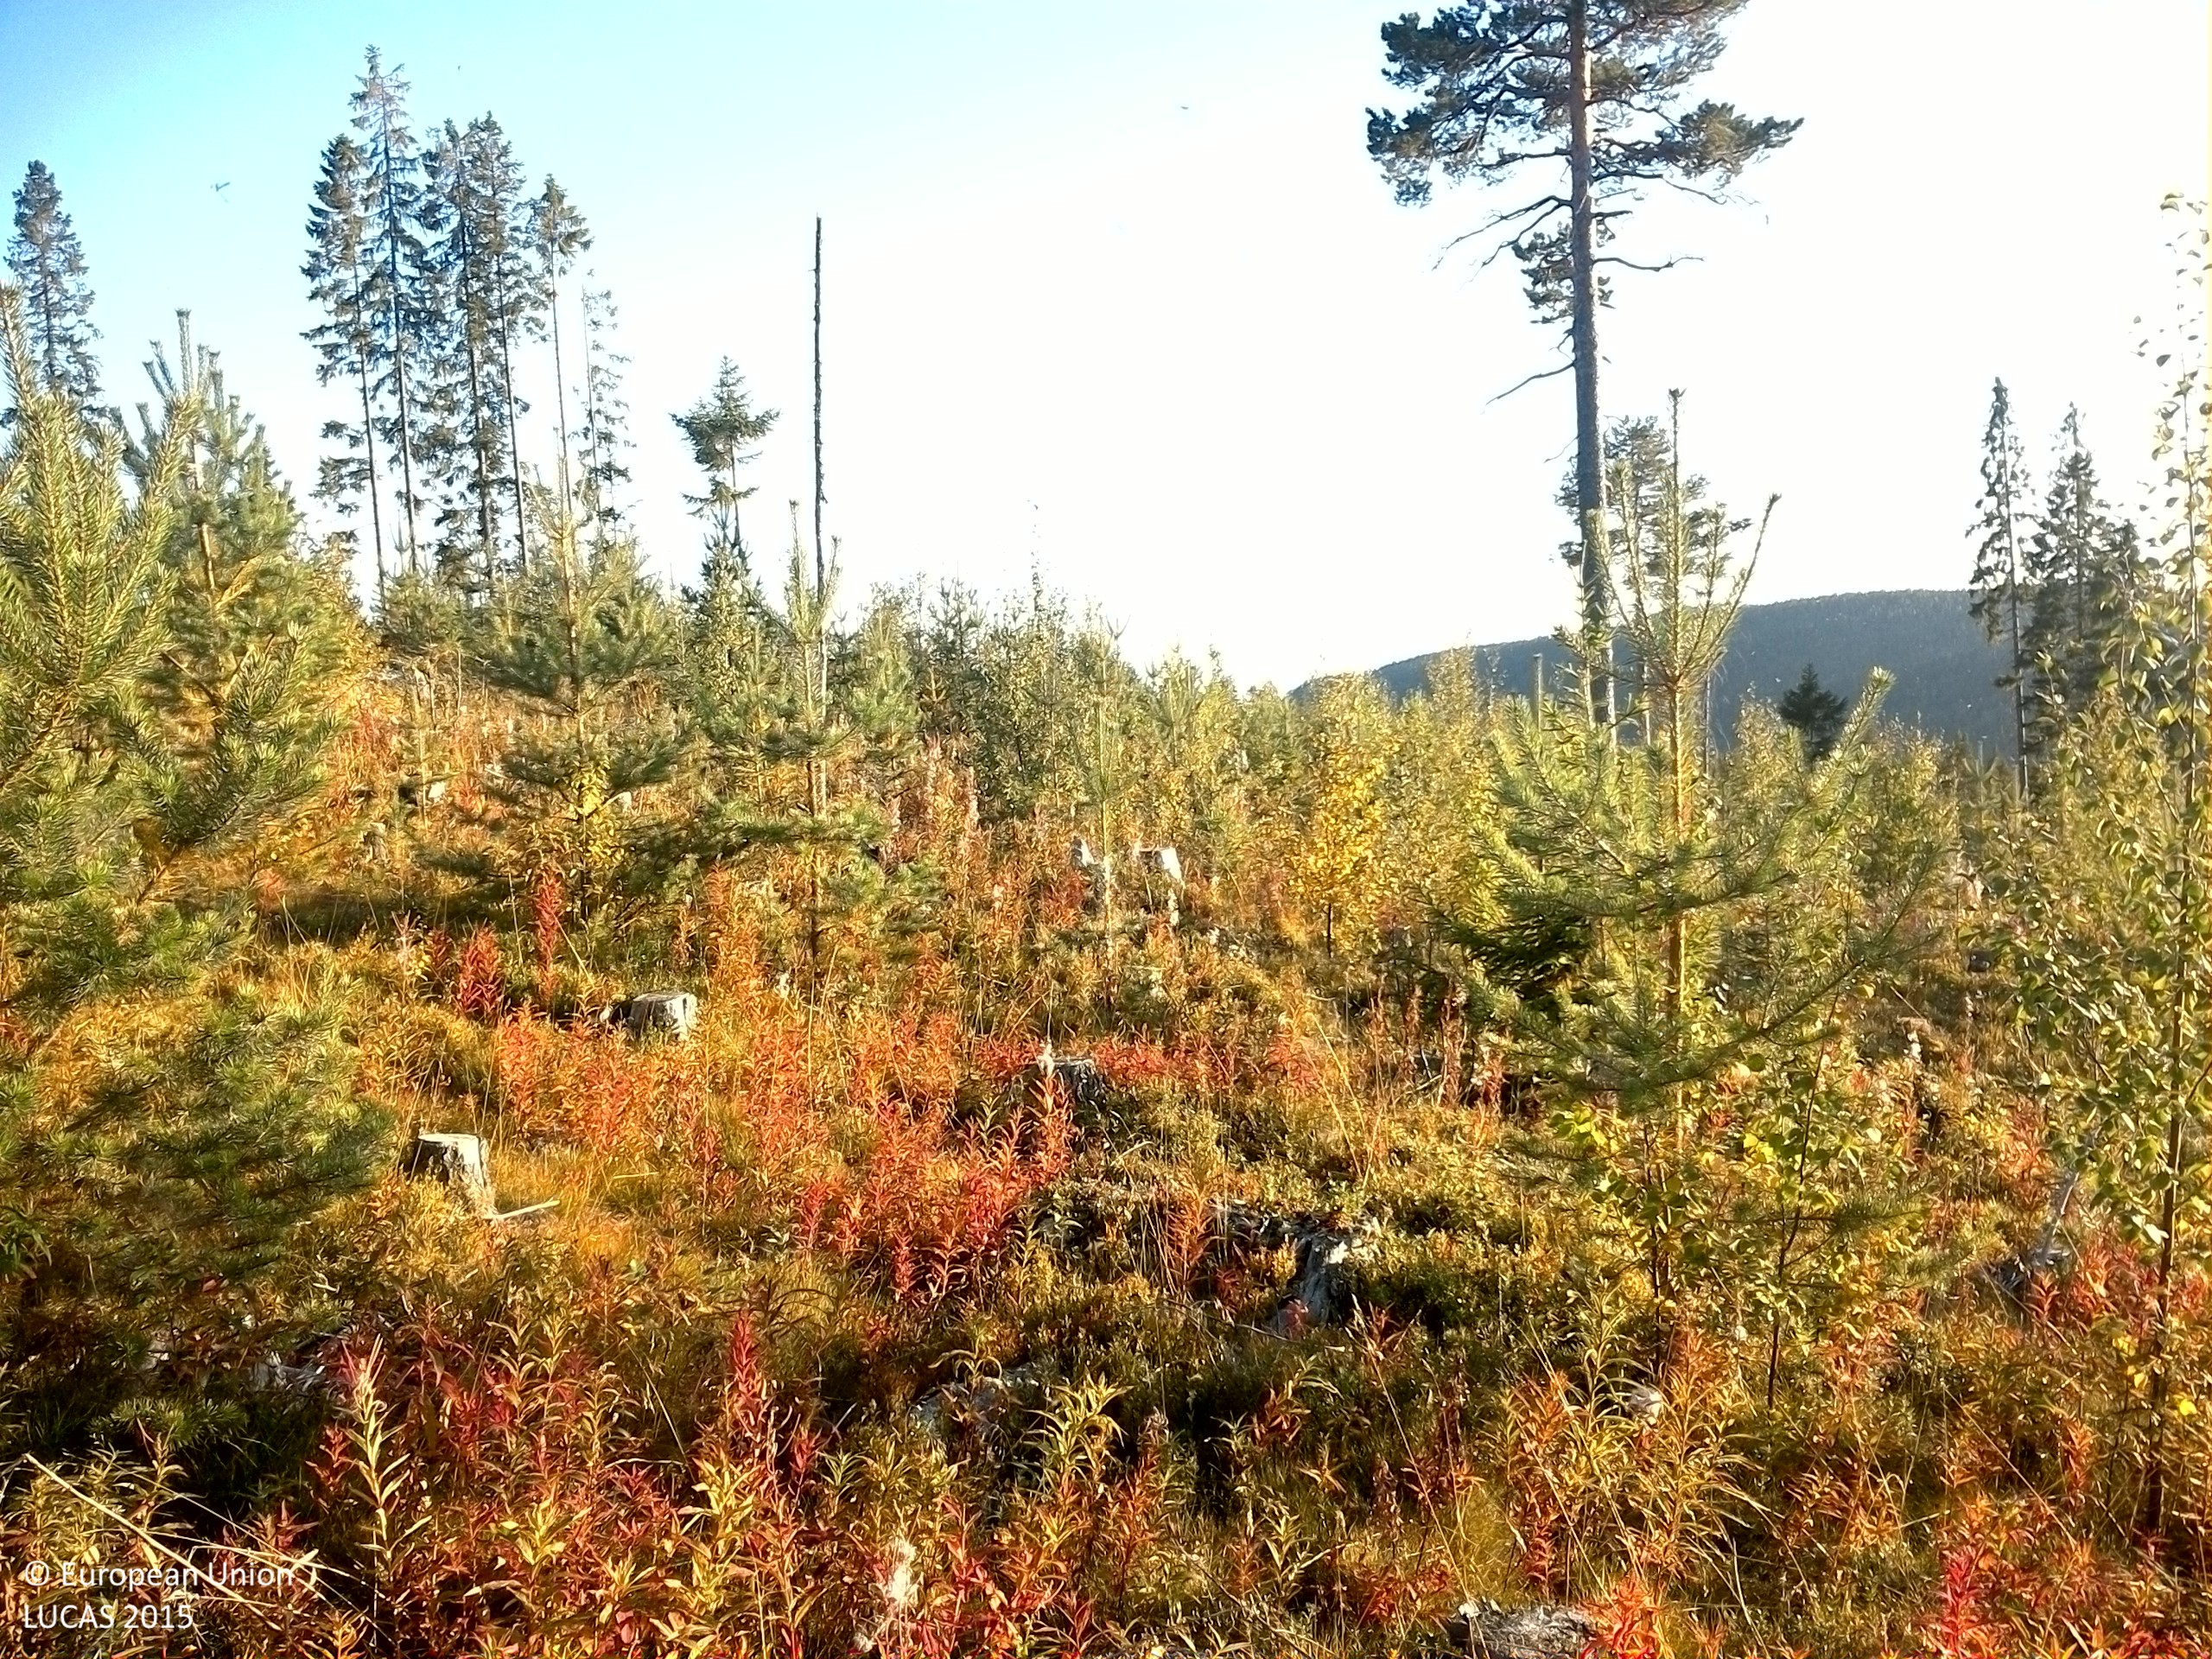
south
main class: Woodland
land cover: Pine dominated mixed woodland
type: boreal forest
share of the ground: 25 - 50 %
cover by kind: shrubs 40 %, coniferous forest trees 25 %, broadleaved forest trees 15 %, herbaceous plants 10 %, lichens and mosses 10 %
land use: Forestry
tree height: < 5 m
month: September
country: SE
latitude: 63.8987
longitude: 16.5923
